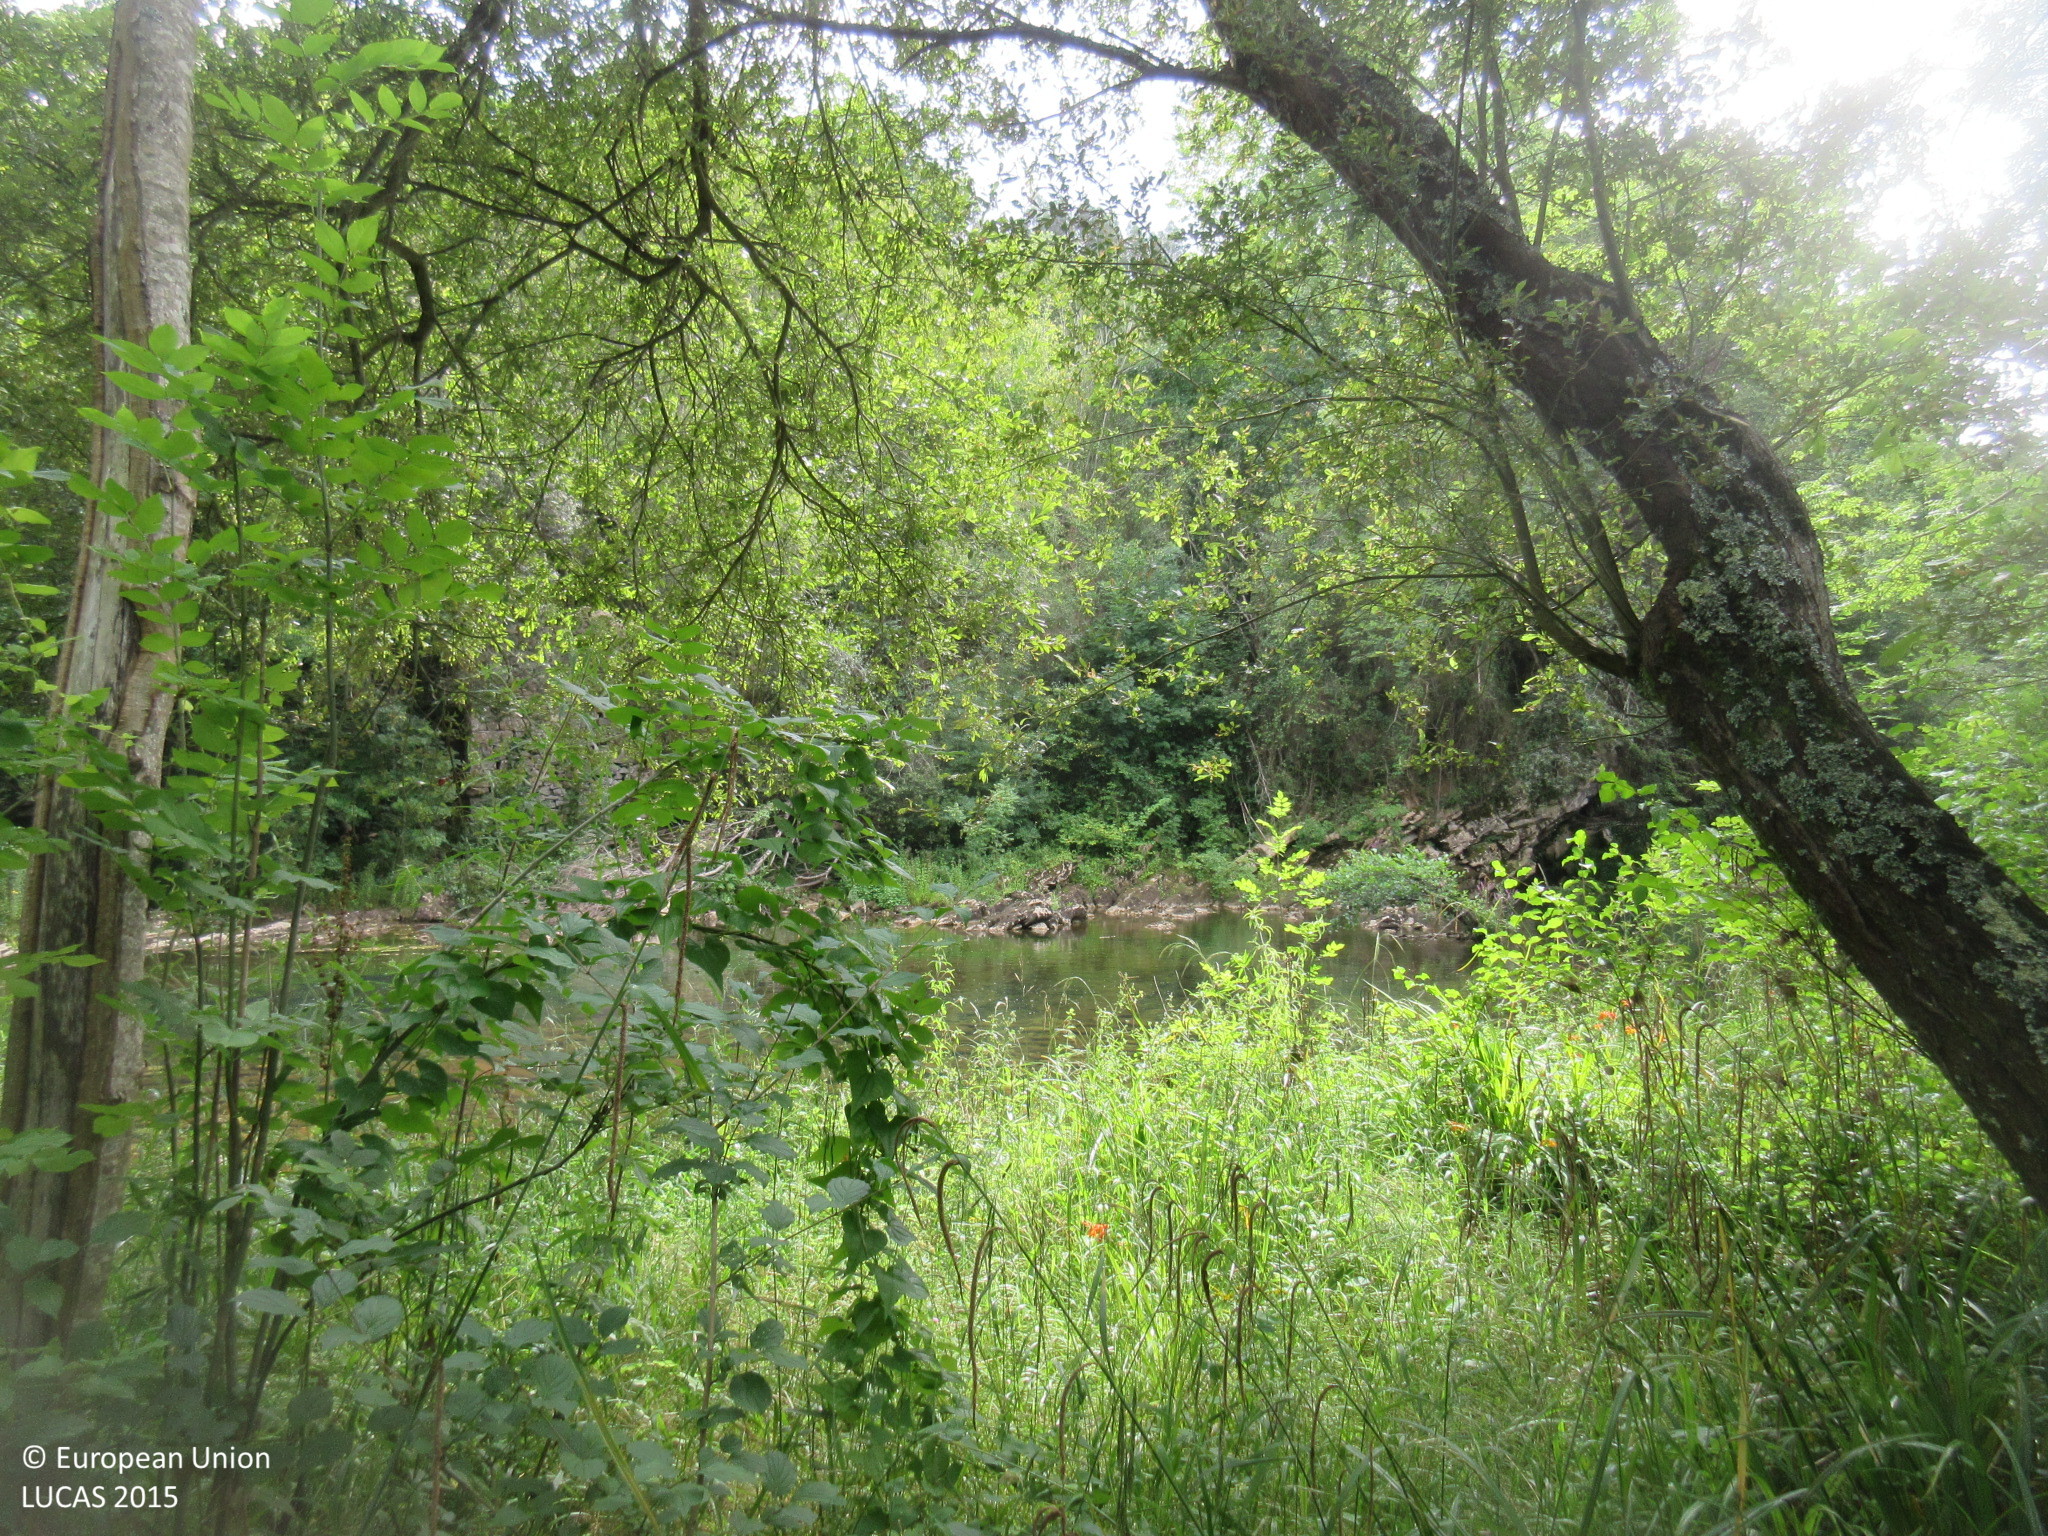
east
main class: Woodland
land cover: Broadleaved woodland
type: floodplain forest
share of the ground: > 75 %
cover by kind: broadleaved forest trees 90 %, shrubs 10 %
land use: Semi-natural and natural areas not in use
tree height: > 5 m
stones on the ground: < 10 %
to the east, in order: Broadleaved woodland; Inland fresh running water; Broadleaved woodland; Grass margins; Paved roads, cycling and walking lanes; Broadleaved woodland; Grassland without tree/shrub cover; Broadleaved woodland; Grassland without tree/shrub cover; Broadleaved woodland
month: July
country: ES
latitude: 43.3115
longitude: -4.4720
